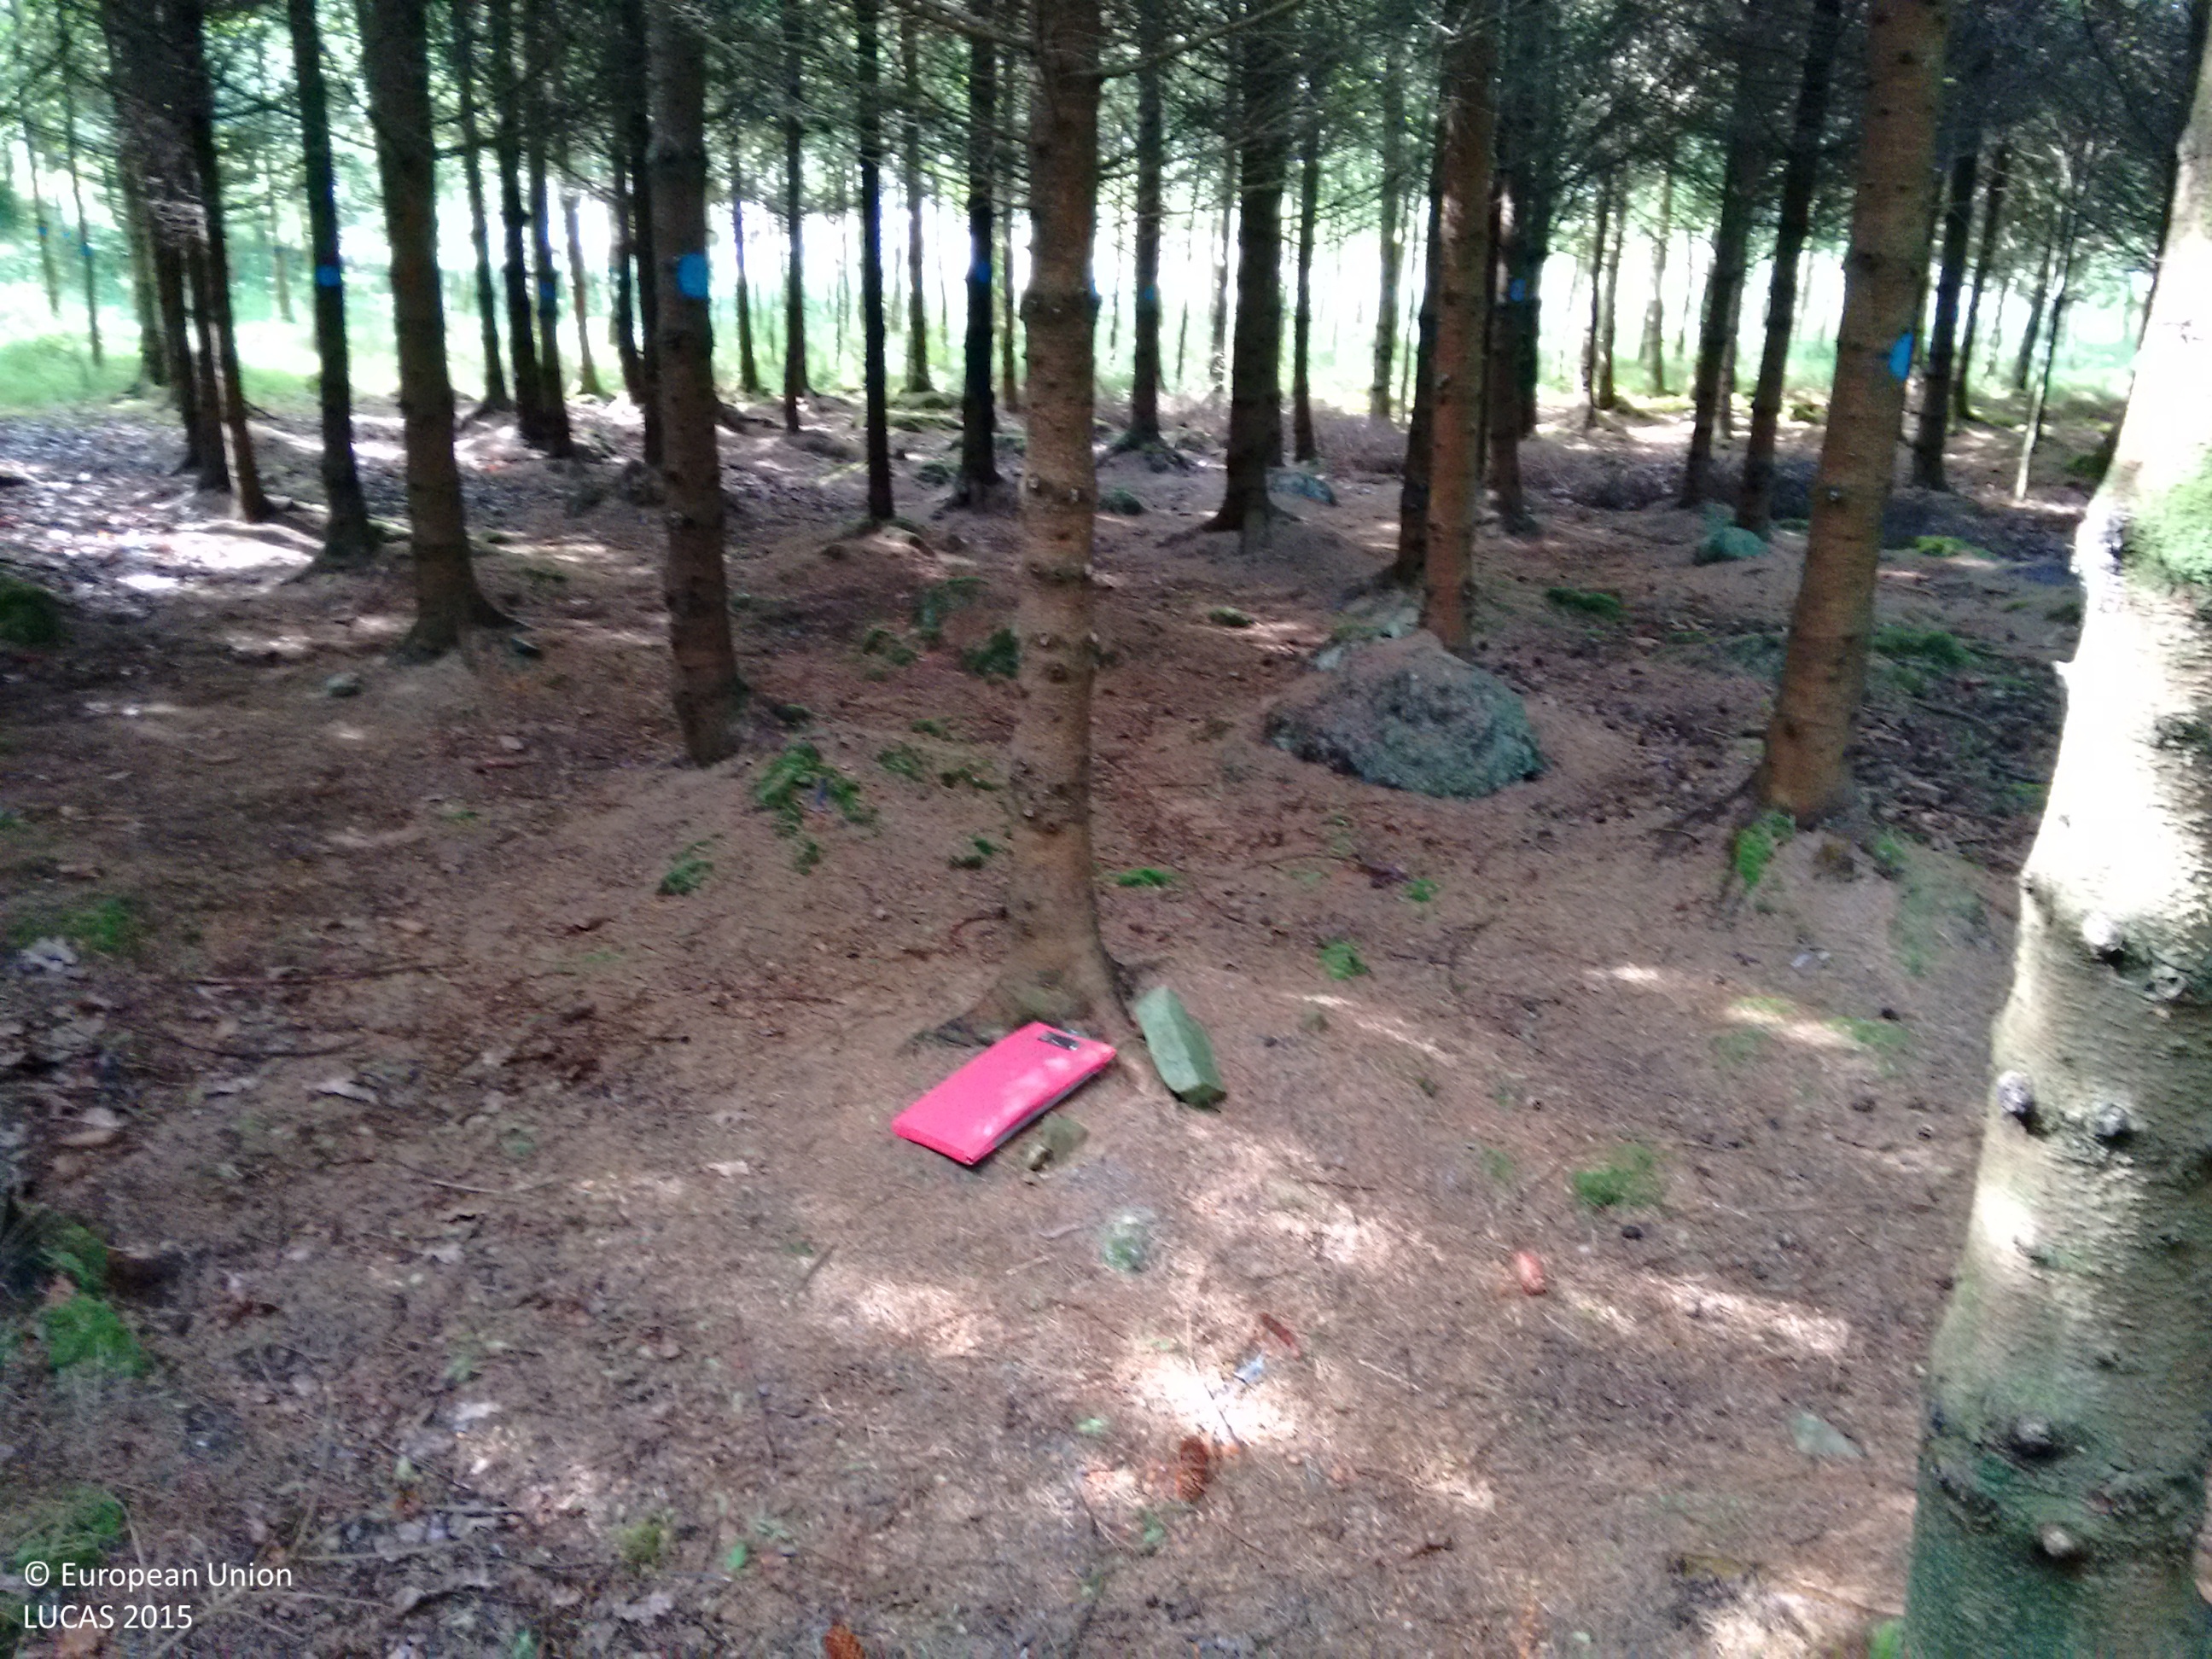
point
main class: Woodland
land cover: Spruce dominated coniferous woodland
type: exotic forest
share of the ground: > 75 %
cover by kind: coniferous forest trees 95 %, lichens and mosses 5 %
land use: Forestry
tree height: > 5 m
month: June
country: IE
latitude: 52.2816
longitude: -7.1058
